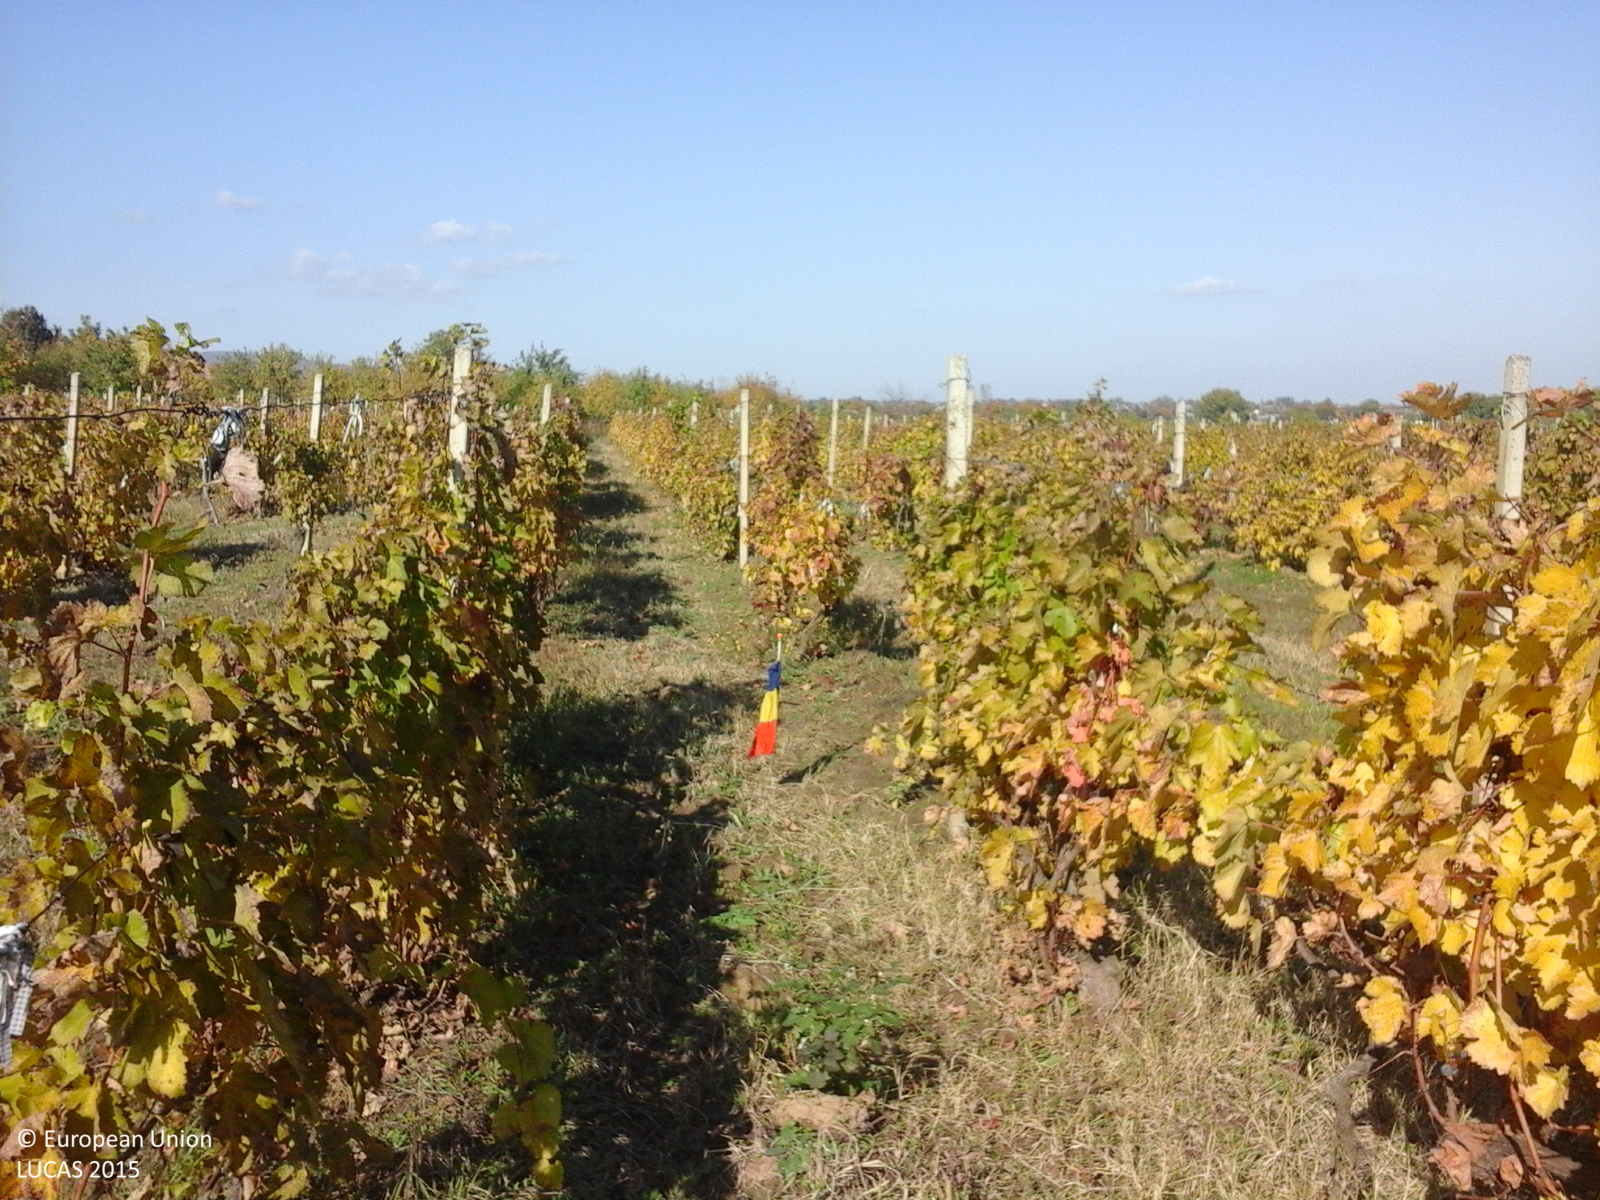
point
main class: Cropland
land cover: Vineyards
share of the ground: > 75 %
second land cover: Grassland without tree/shrub cover
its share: > 75 %
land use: Agriculture (excluding fallow land and kitchen gardens)
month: October
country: RO
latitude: 45.6646
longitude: 27.0722
